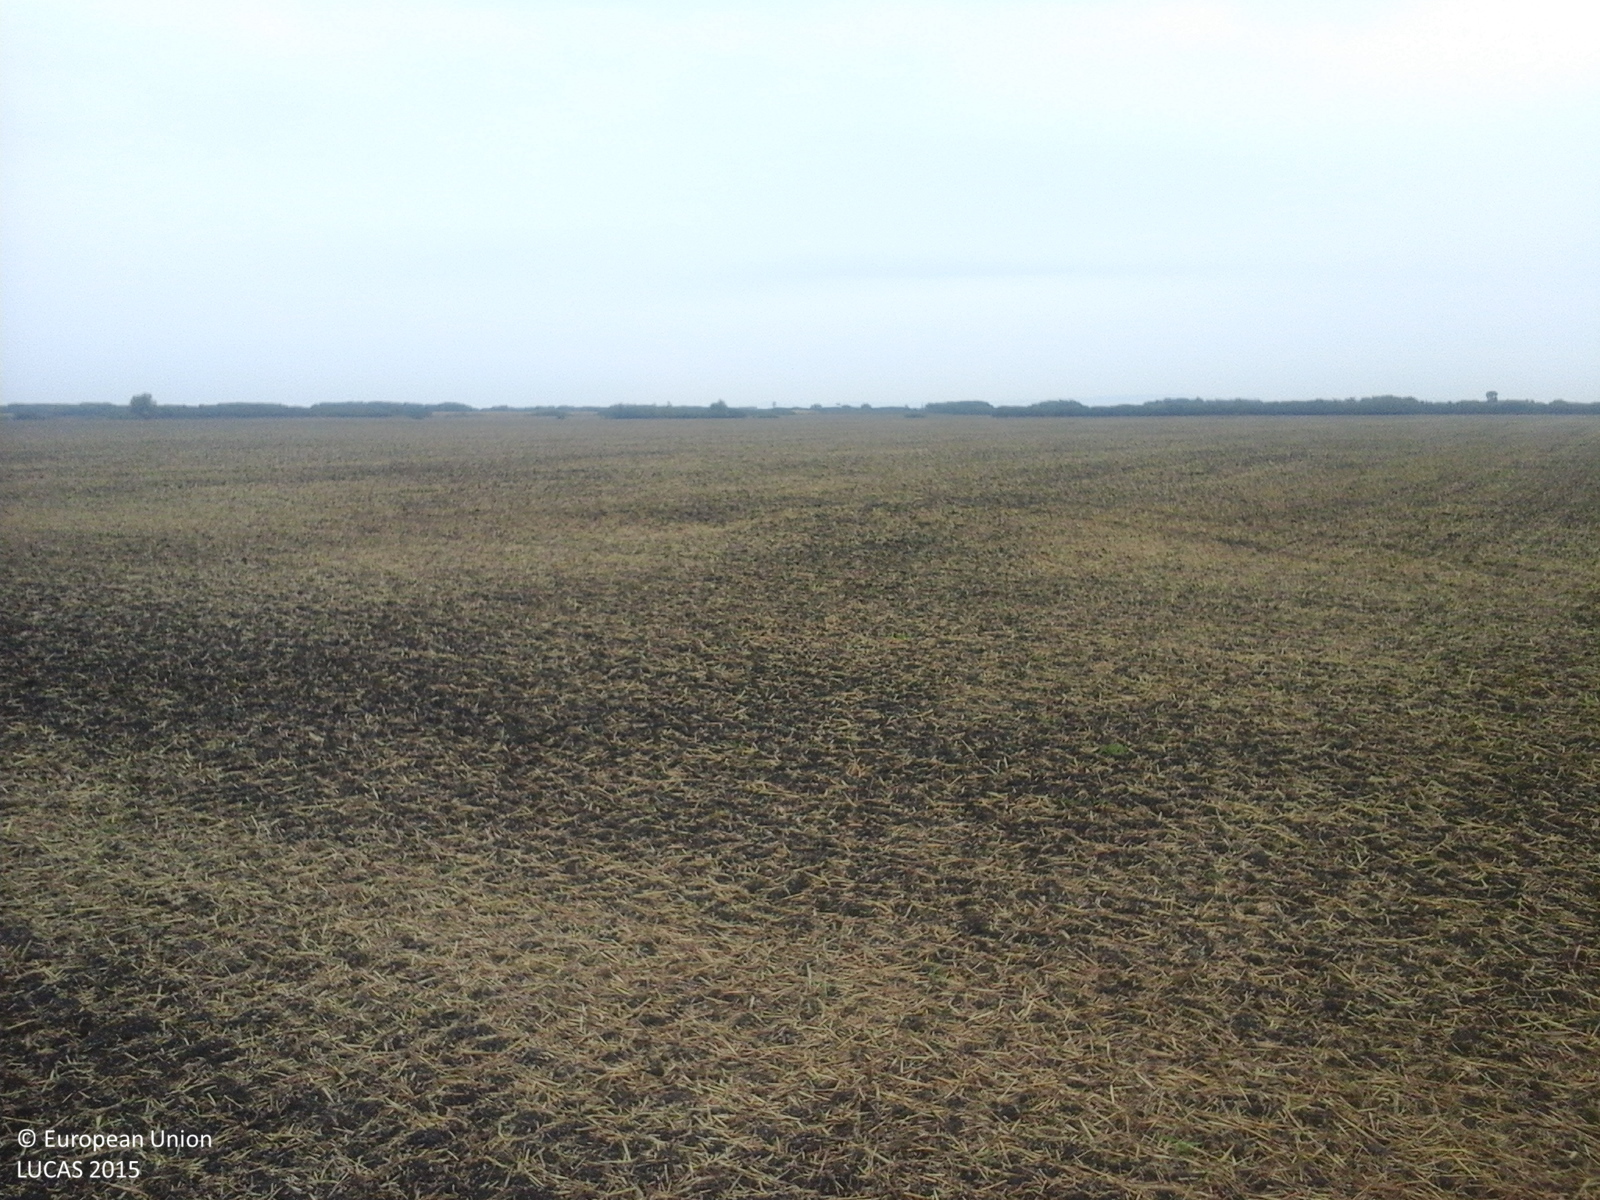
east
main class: Cropland
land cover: Common wheat
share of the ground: < 10 %
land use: Agriculture (excluding fallow land and kitchen gardens)
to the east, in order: Common wheat
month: September
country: RO
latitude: 47.6091
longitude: 22.5766
